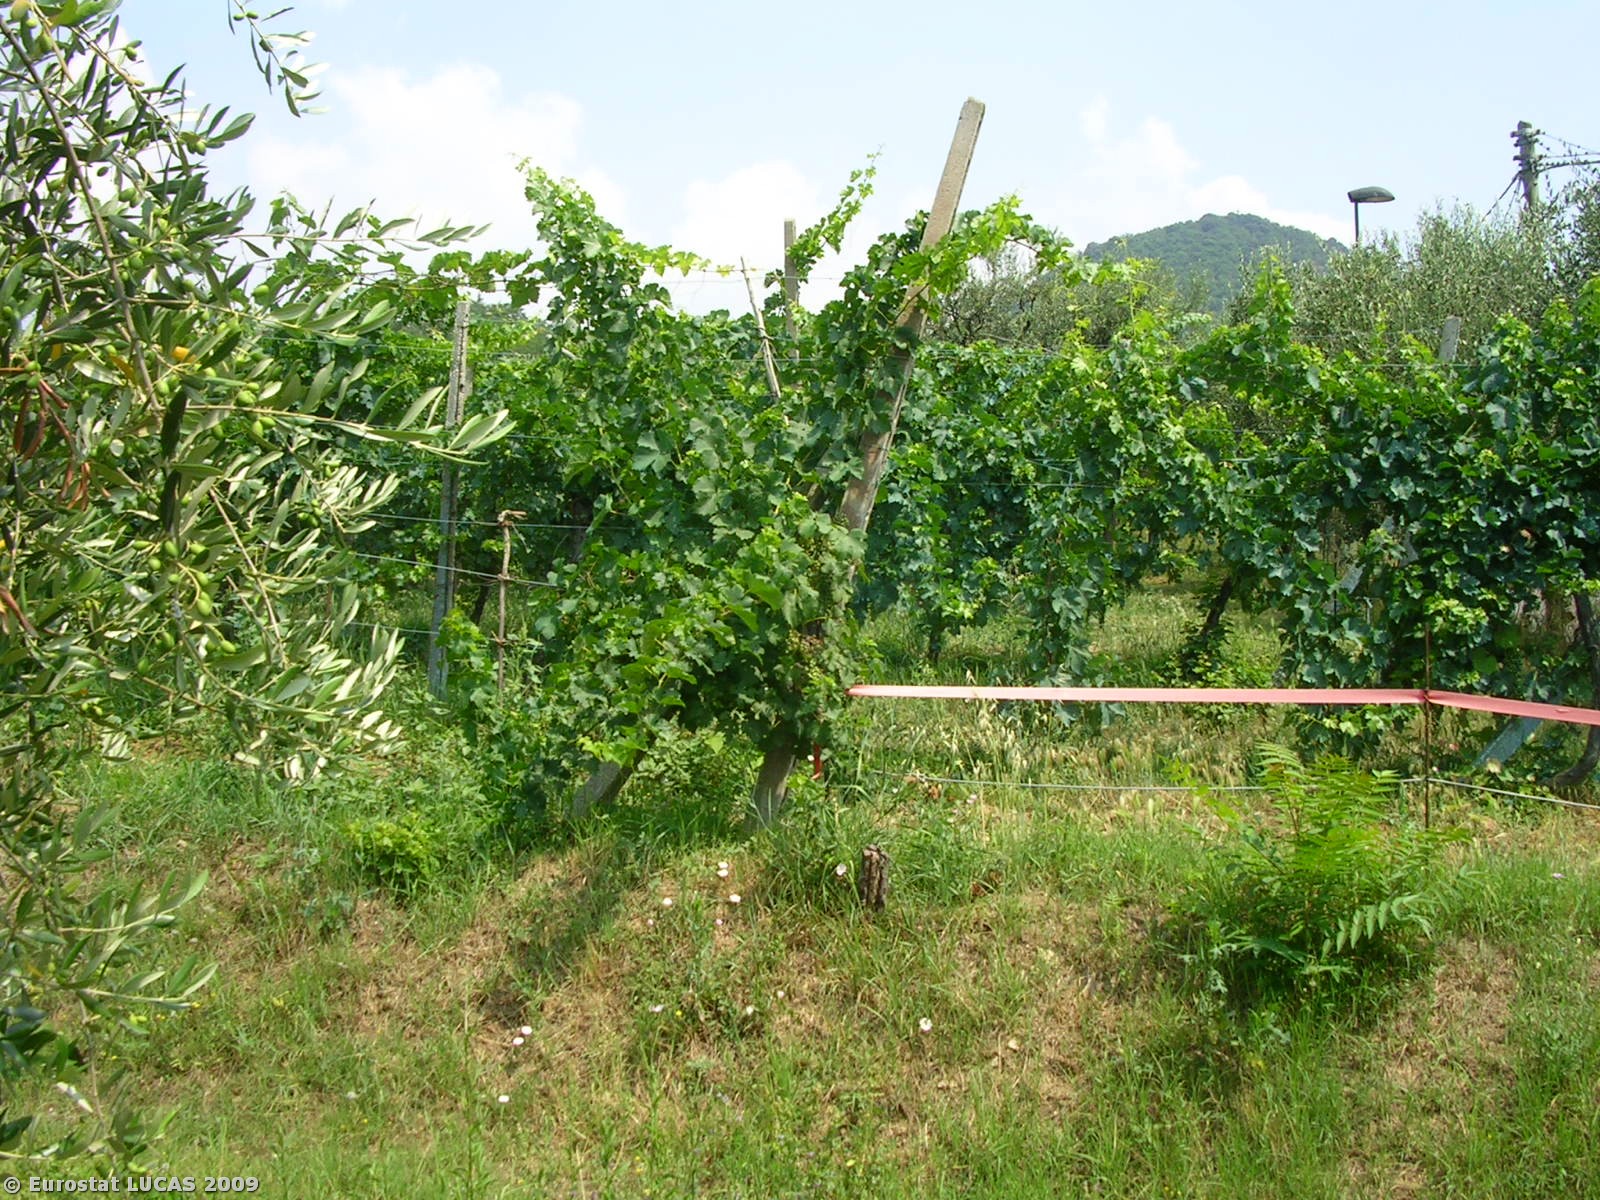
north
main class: Cropland
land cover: Olive groves
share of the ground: 50 - 75 %
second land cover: Grassland with sparse tree/shrub cover
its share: 50 - 75 %
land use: Agriculture (excluding fallow land and kitchen gardens)
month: July
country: IT
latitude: 45.2389
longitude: 11.6659
